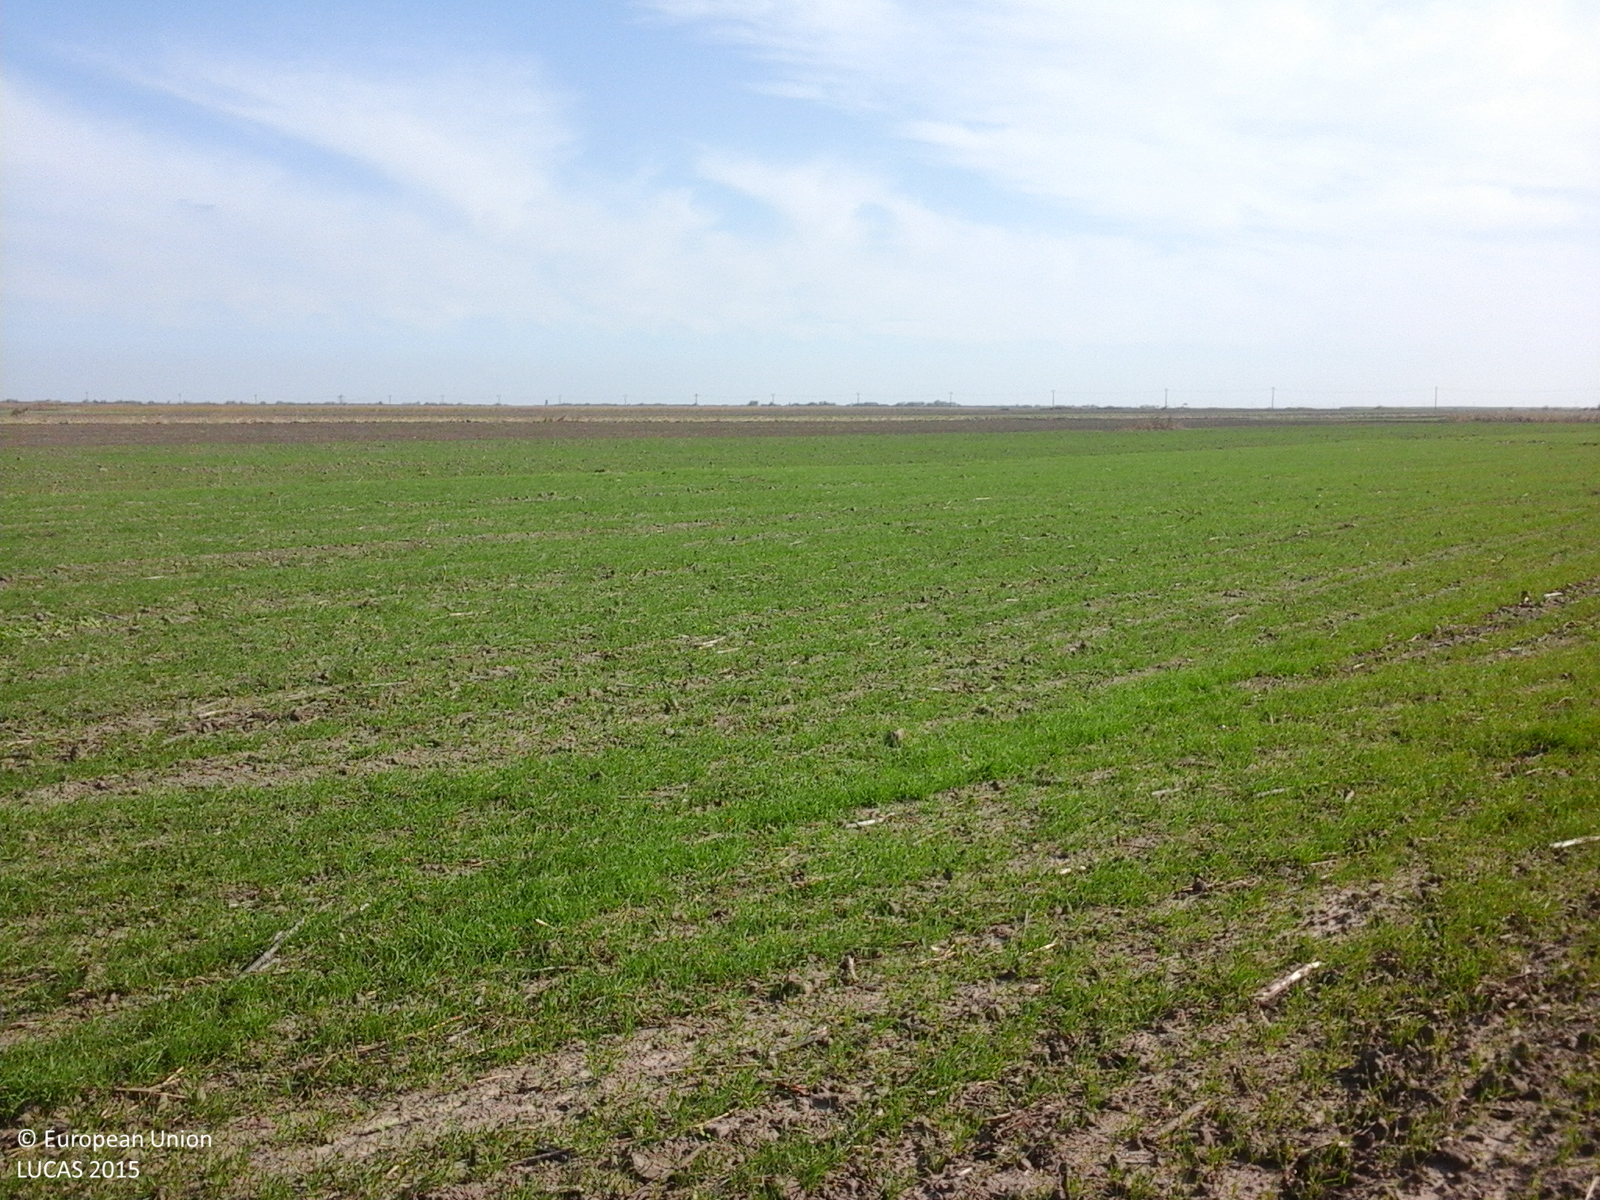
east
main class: Cropland
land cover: Common wheat
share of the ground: 10 - 25 %
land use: Agriculture (excluding fallow land and kitchen gardens)
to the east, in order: Common wheat; Other bare soil; Maize
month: October
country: RO
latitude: 45.4627
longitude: 27.4029
